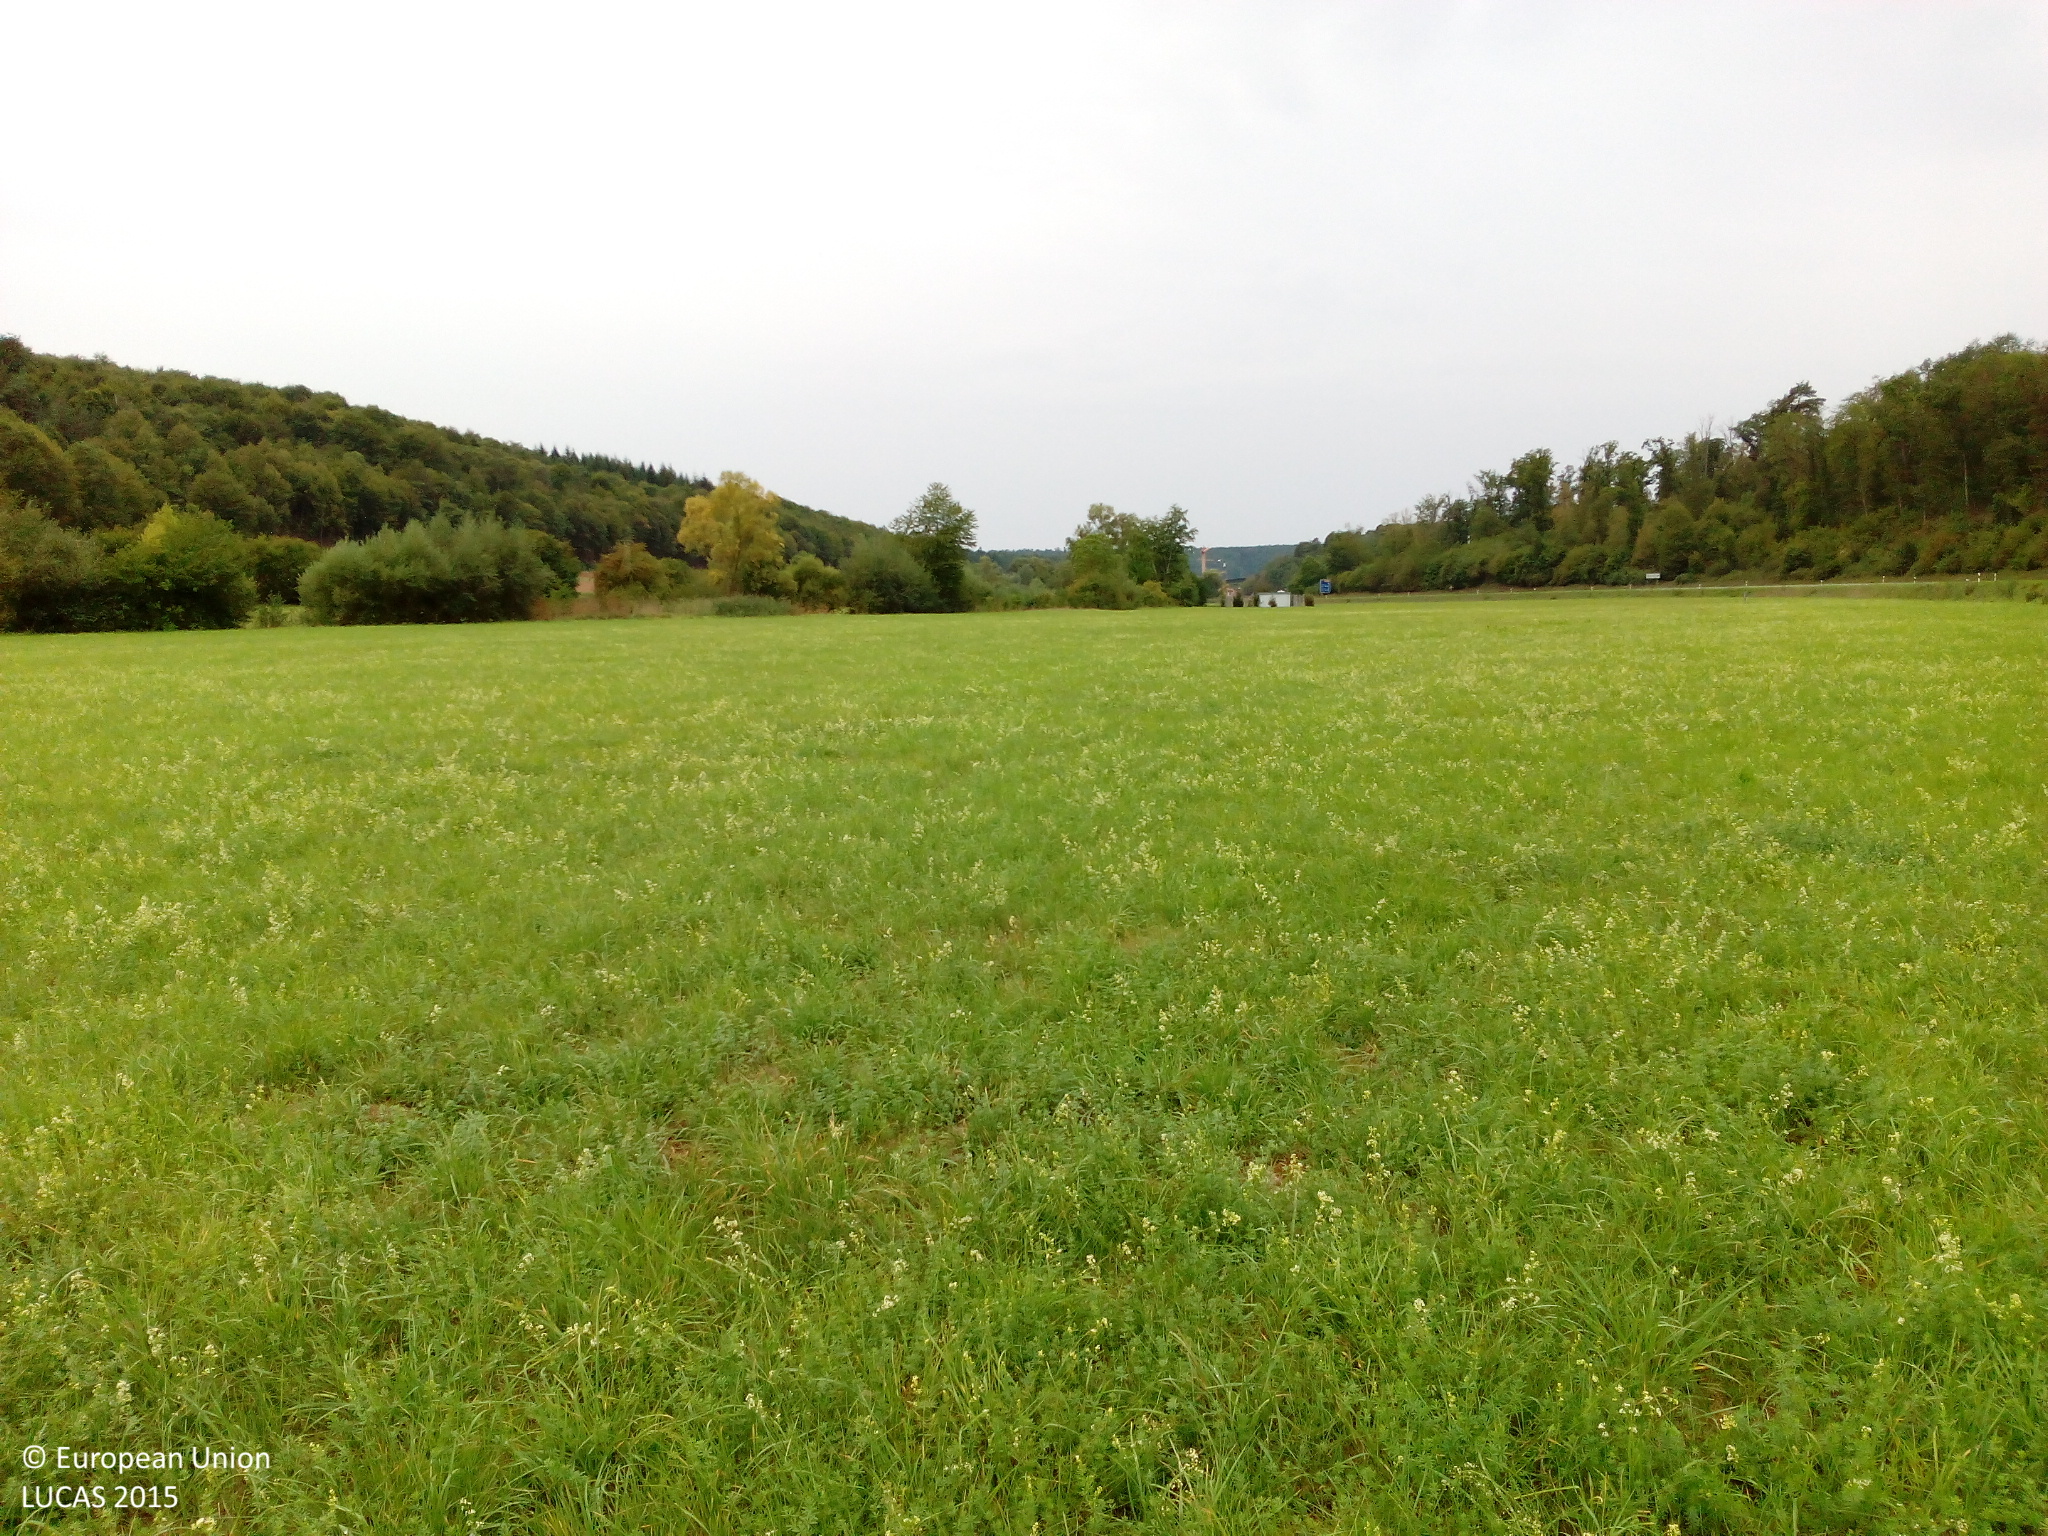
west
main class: Grassland
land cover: Grassland without tree/shrub cover
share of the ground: > 75 %
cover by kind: herbaceous plants 85 %, unconsolidated bare surface 10 %, lichens and mosses 5 %
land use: Agriculture (excluding fallow land and kitchen gardens)
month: September
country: DE
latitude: 49.7699
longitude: 9.5975
